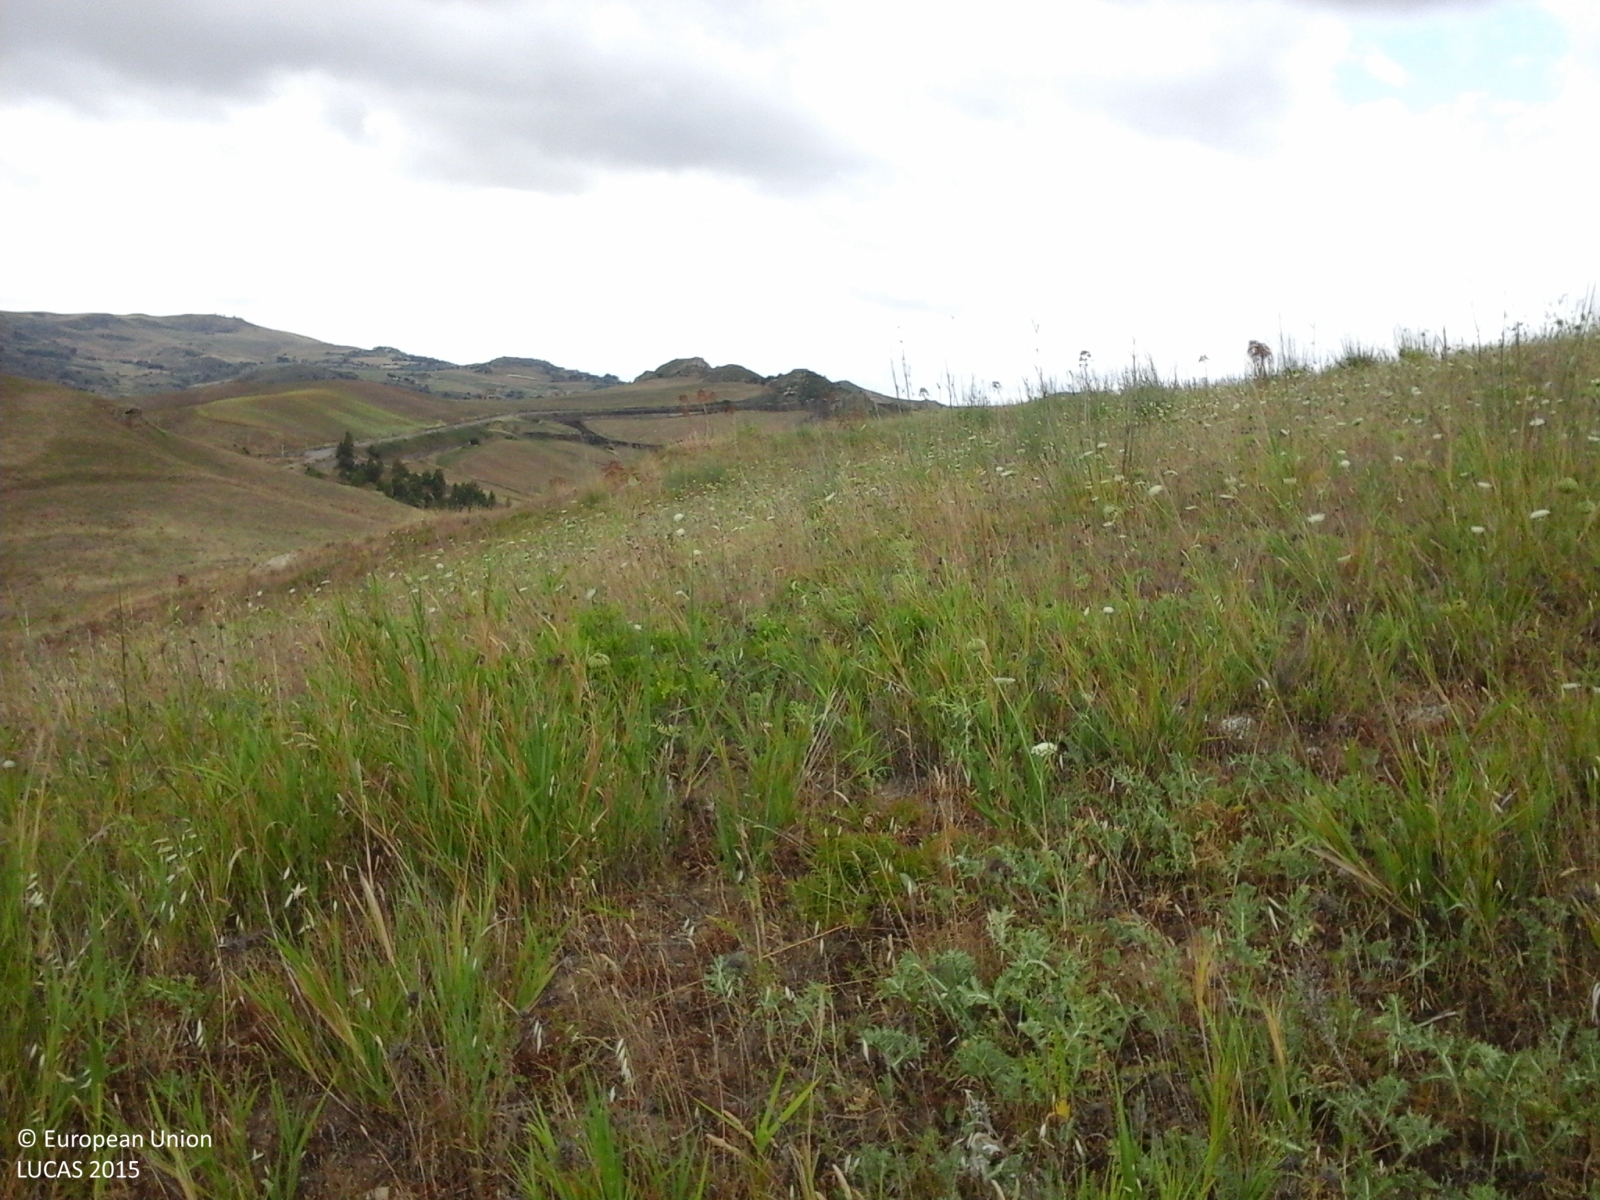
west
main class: Grassland
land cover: Grassland without tree/shrub cover
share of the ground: > 75 %
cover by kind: herbaceous plants 70 %, consolidated bare surface 20 %, unconsolidated bare surface 10 %
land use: Agriculture (excluding fallow land and kitchen gardens)
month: June
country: IT
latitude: 37.6034
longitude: 14.1268
